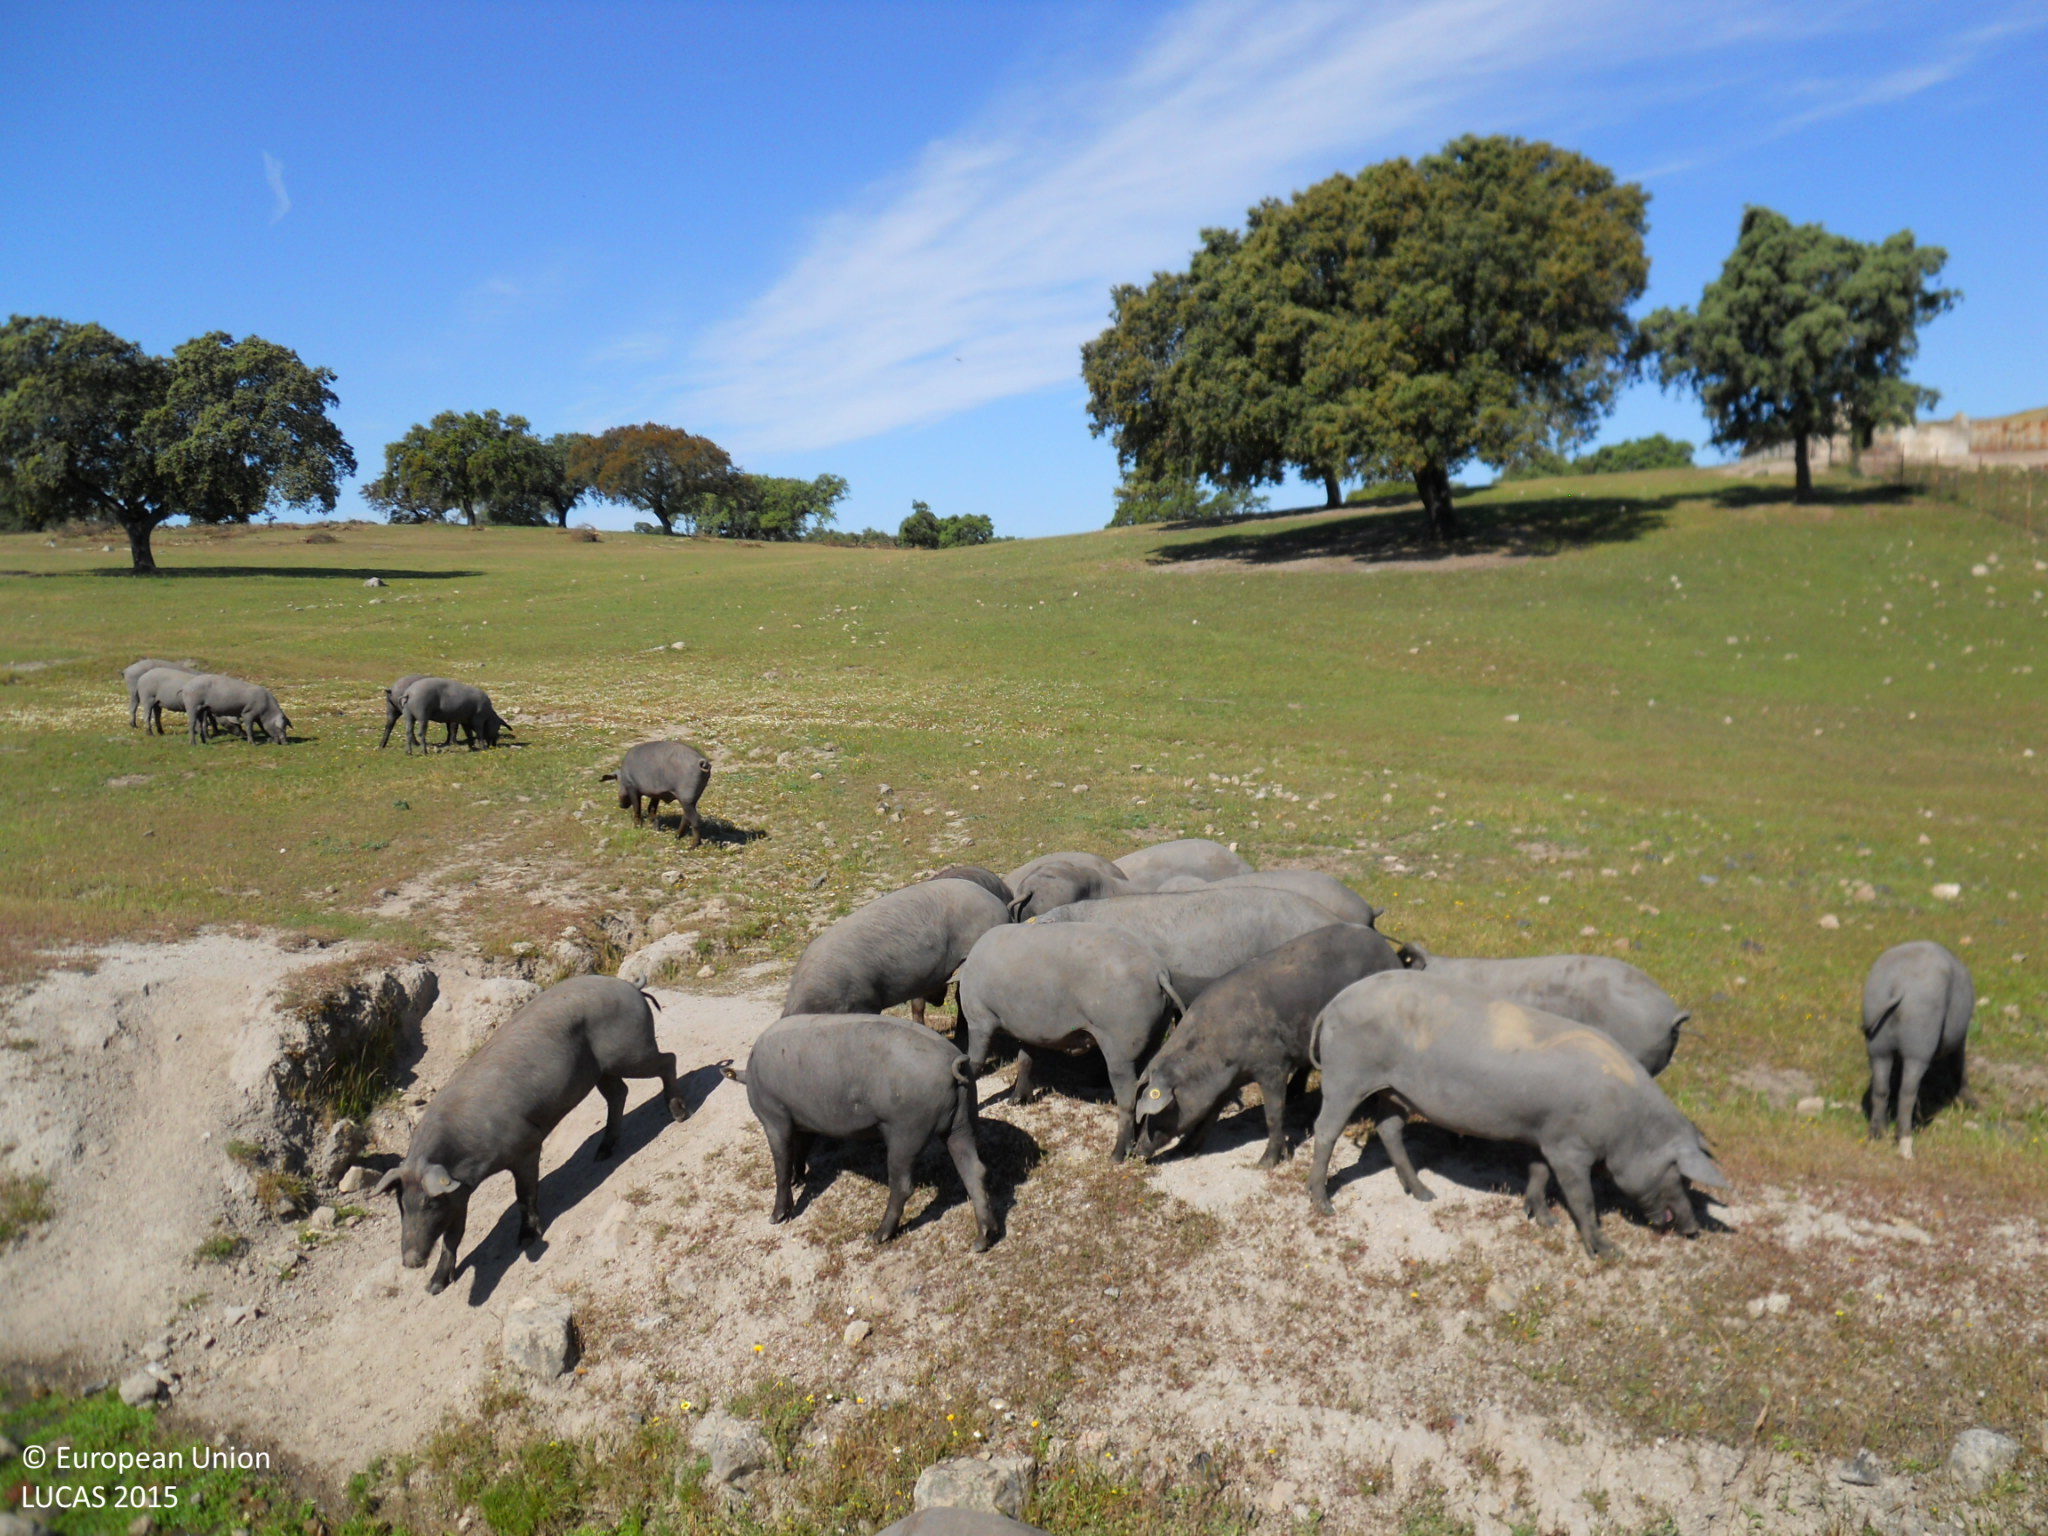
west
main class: Grassland
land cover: Grassland with sparse tree/shrub cover
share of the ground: > 75 %
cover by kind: herbaceous plants 70 %, unconsolidated bare surface 20 %, broadleaved forest trees 5 %, shrubs 5 %
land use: Agriculture (excluding fallow land and kitchen gardens)
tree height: > 5 m
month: April
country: ES
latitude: 39.3202
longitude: -7.0254
